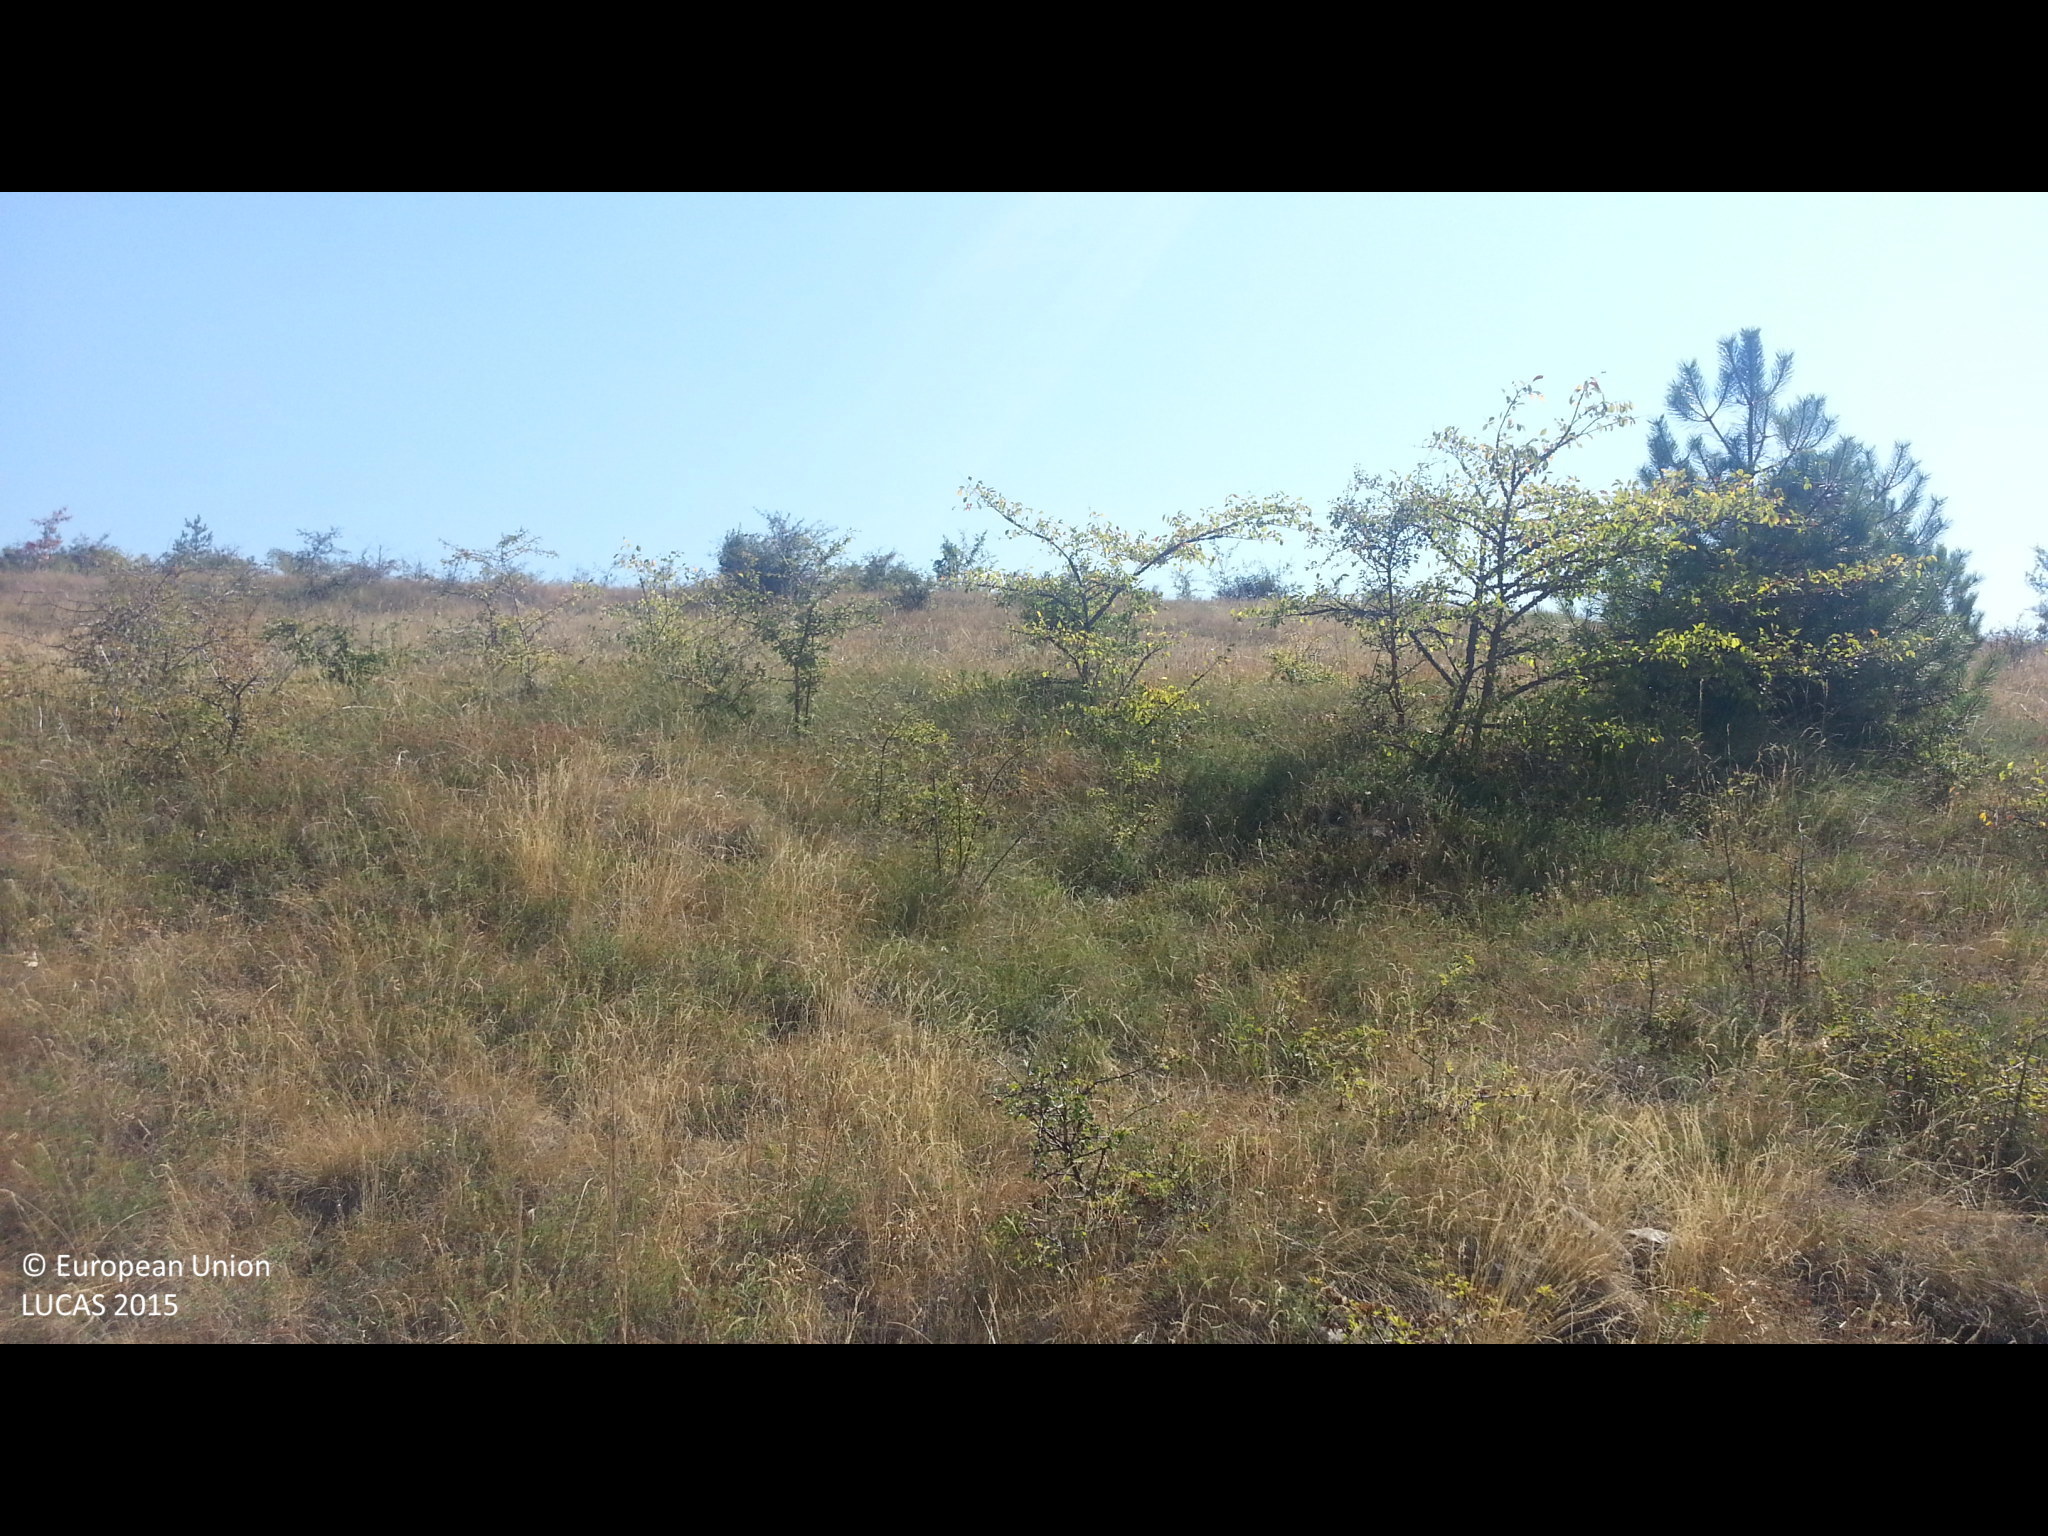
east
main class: Grassland
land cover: Grassland with sparse tree/shrub cover
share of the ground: > 75 %
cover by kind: herbaceous plants 90 %, broadleaved forest trees 5 %, shrubs 5 %
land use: Agriculture (excluding fallow land and kitchen gardens)
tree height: < 5 m
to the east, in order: Grassland with sparse tree/shrub cover; Tracks; Grassland with sparse tree/shrub cover; Grassland without tree/shrub cover
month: August
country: BG
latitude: 42.4923
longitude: 23.1088
